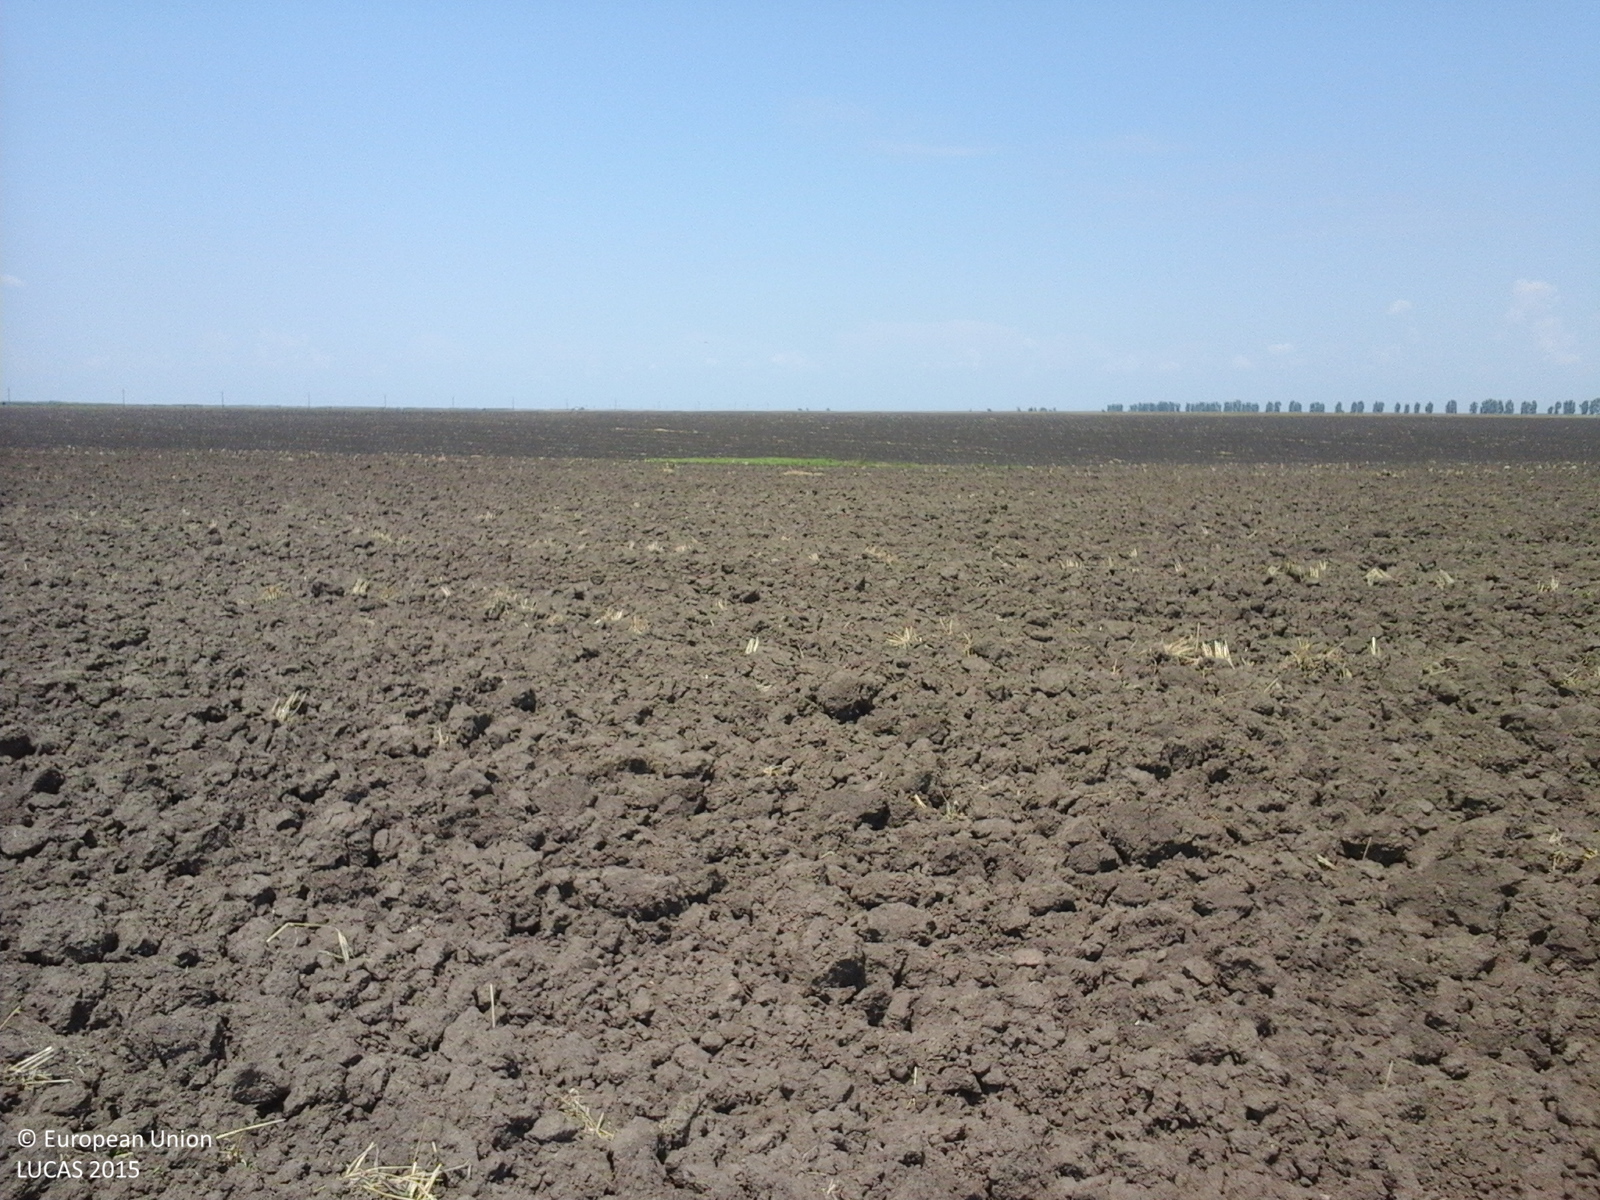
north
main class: Cropland
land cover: Common wheat
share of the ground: < 10 %
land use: Agriculture (excluding fallow land and kitchen gardens)
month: July
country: RO
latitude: 44.0900
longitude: 25.7684
